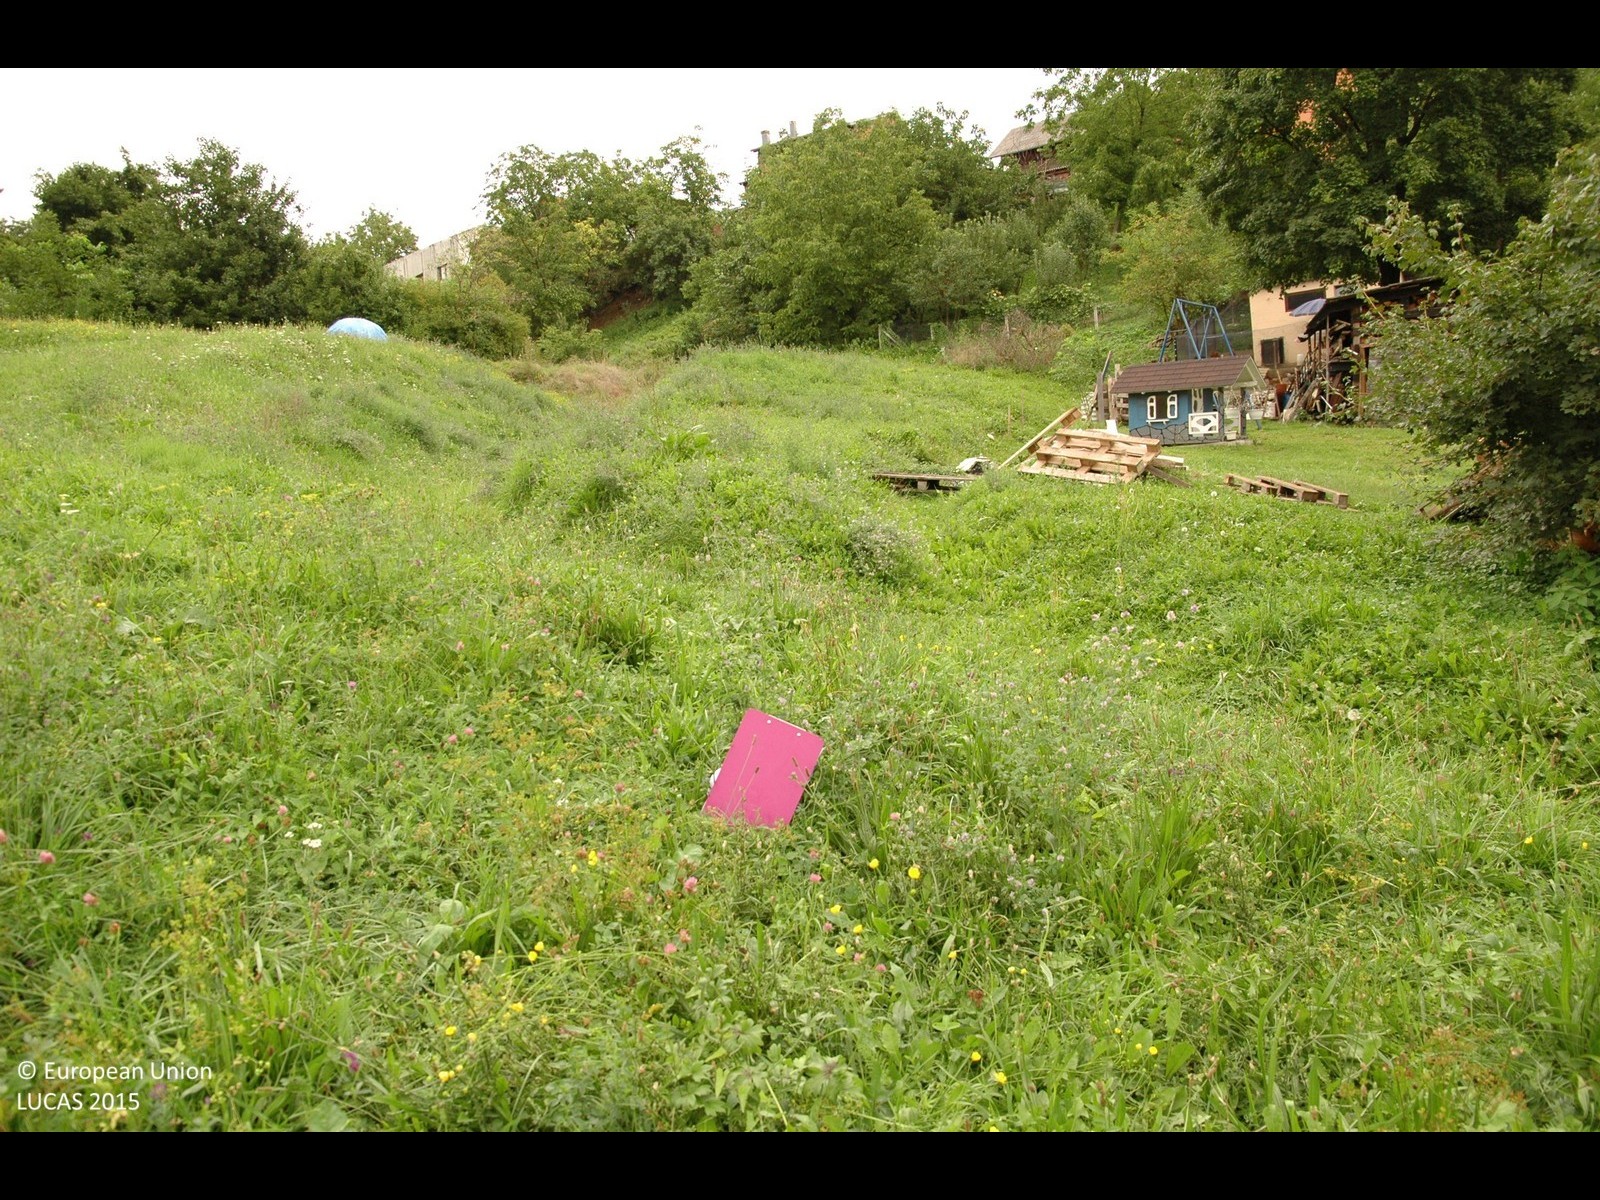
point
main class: Grassland
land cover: Grassland without tree/shrub cover
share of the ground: > 75 %
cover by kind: herbaceous plants 100 %
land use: Agriculture (excluding fallow land and kitchen gardens)
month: August
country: HR
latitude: 45.8720
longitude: 16.0660
